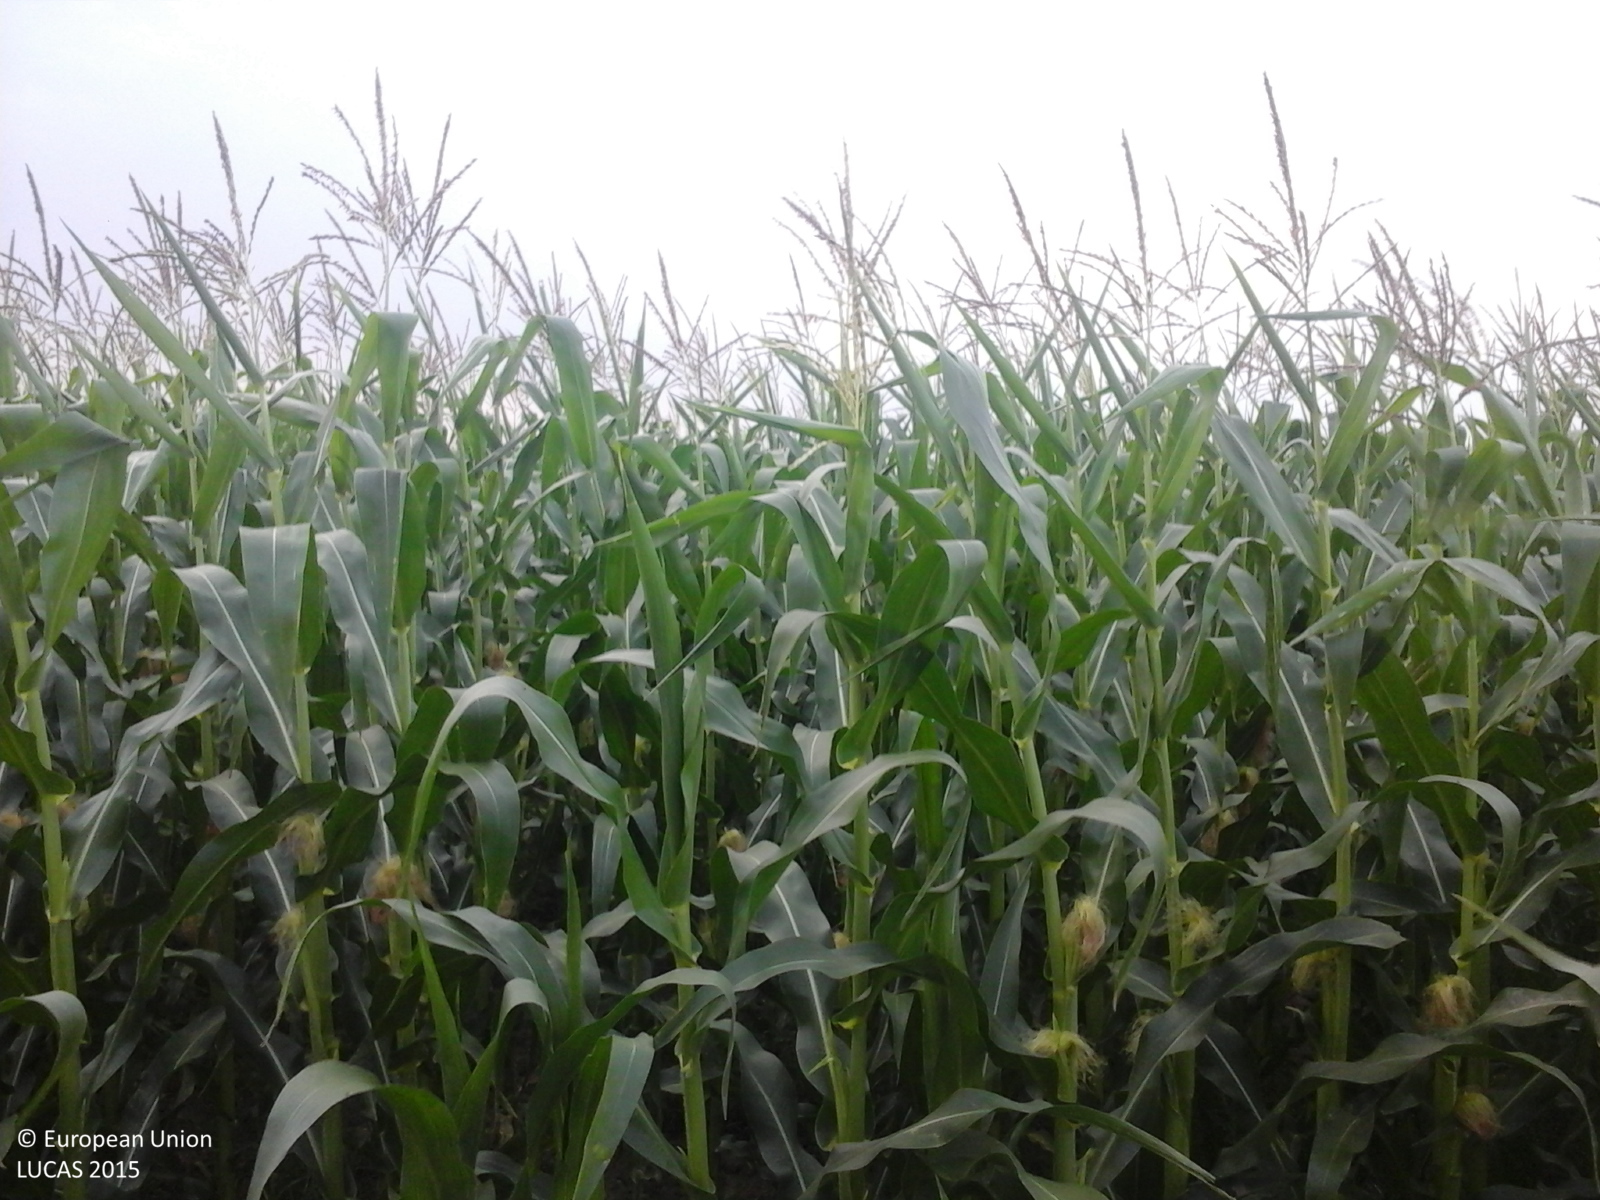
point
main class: Cropland
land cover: Maize
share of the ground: > 75 %
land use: Agriculture (excluding fallow land and kitchen gardens)
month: July
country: RO
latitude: 43.8696
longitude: 24.6648
